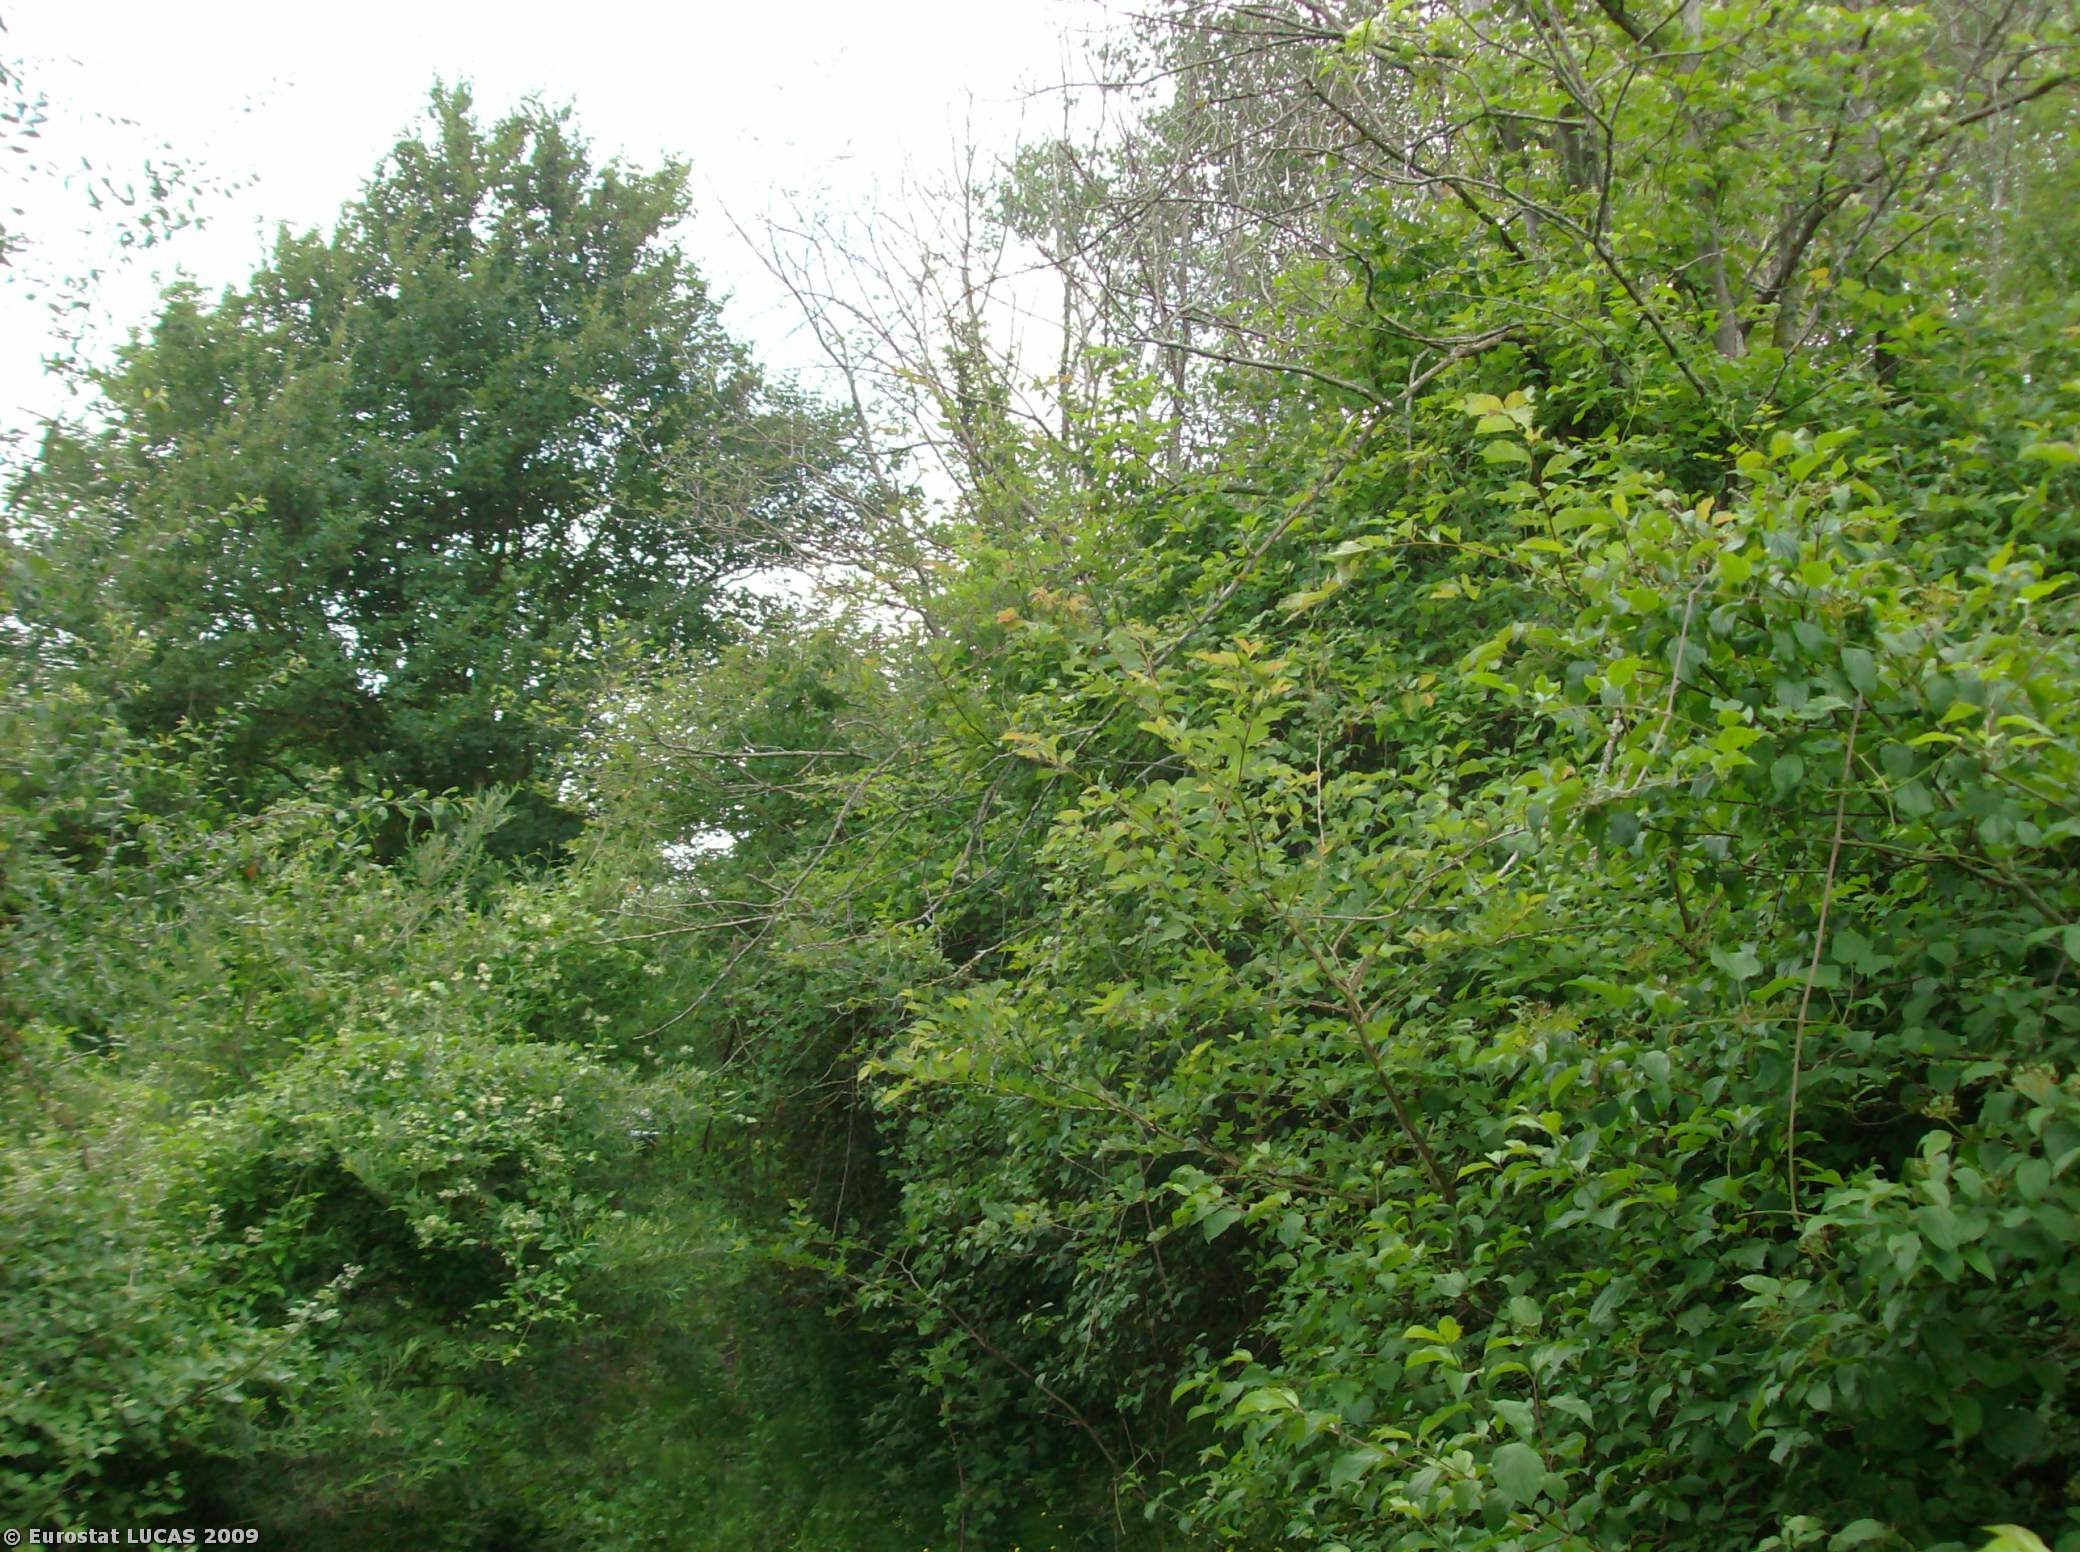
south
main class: Woodland
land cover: Broadleaved woodland
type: thermophilous deciduous forest
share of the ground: > 75 %
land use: Unused
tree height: > 5 m
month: June
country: IT
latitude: 42.8931
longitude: 11.6724
